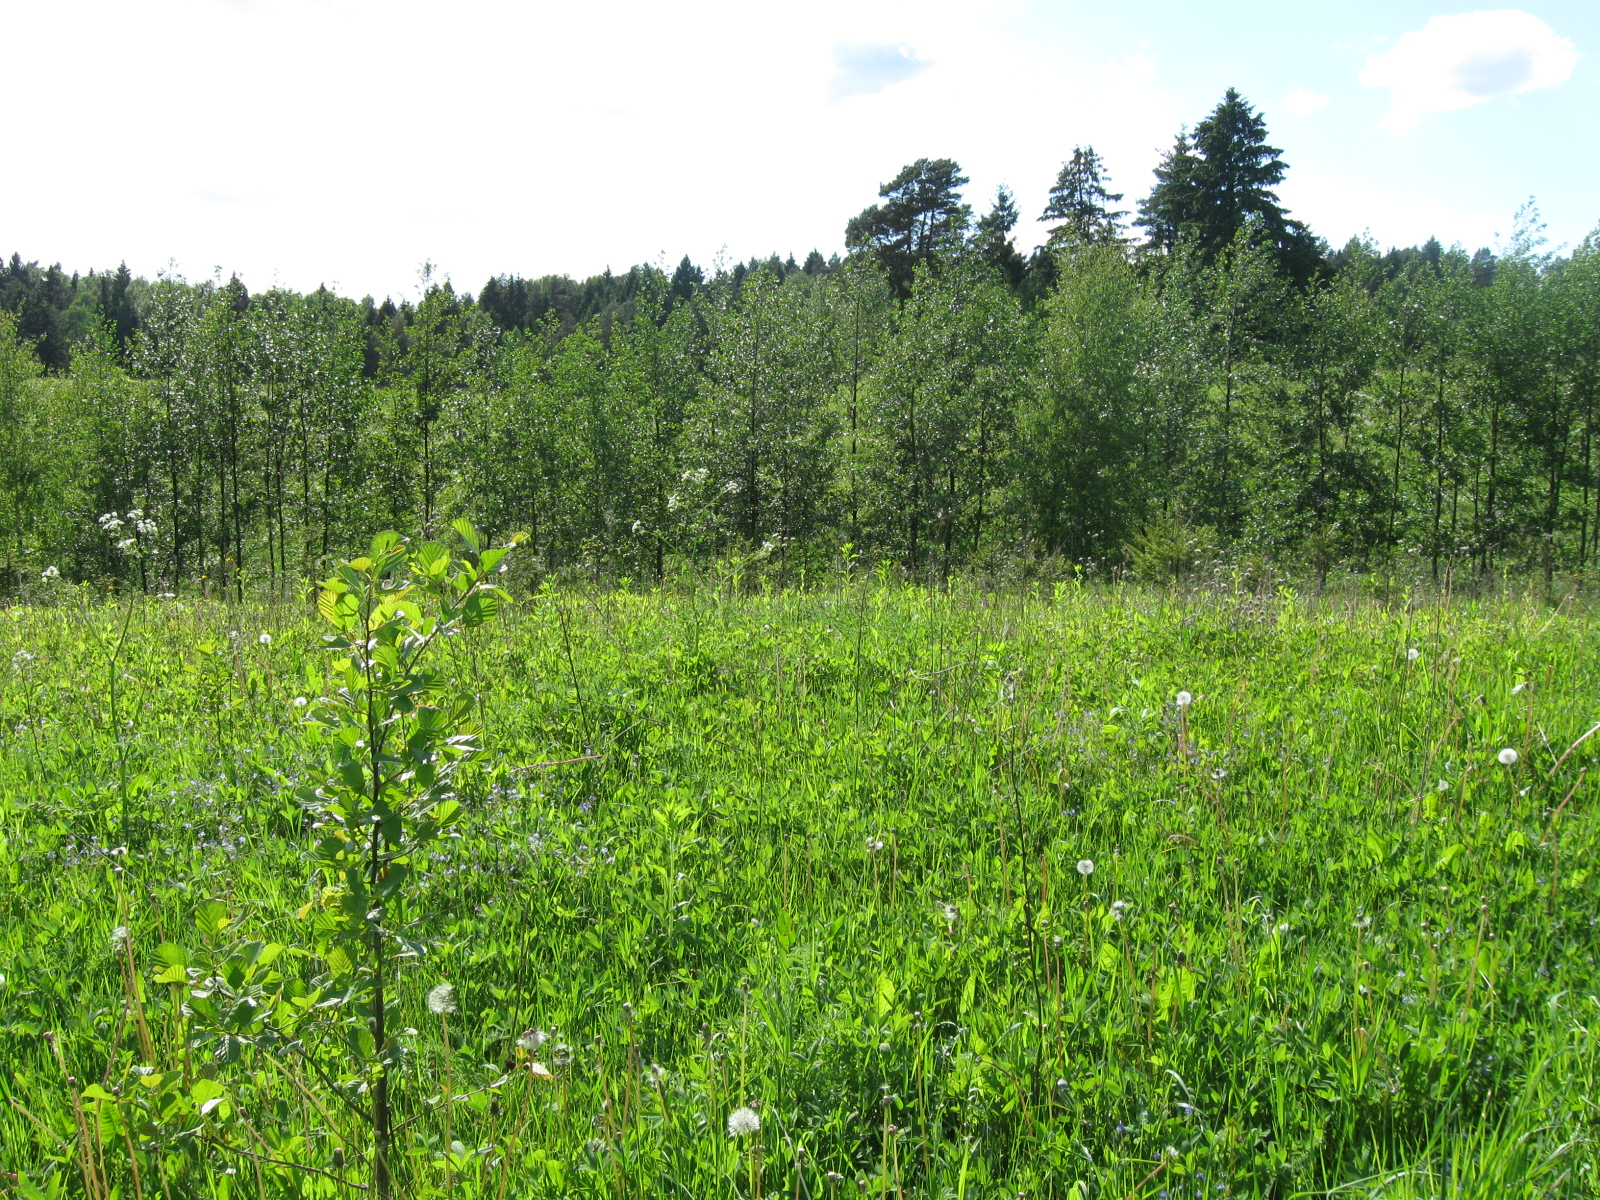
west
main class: Grassland
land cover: Grassland with sparse tree/shrub cover
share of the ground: > 75 %
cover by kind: herbaceous plants 95 %, broadleaved forest trees 5 %
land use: Abandoned areas
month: May
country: LT
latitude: 54.2415
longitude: 23.3840
